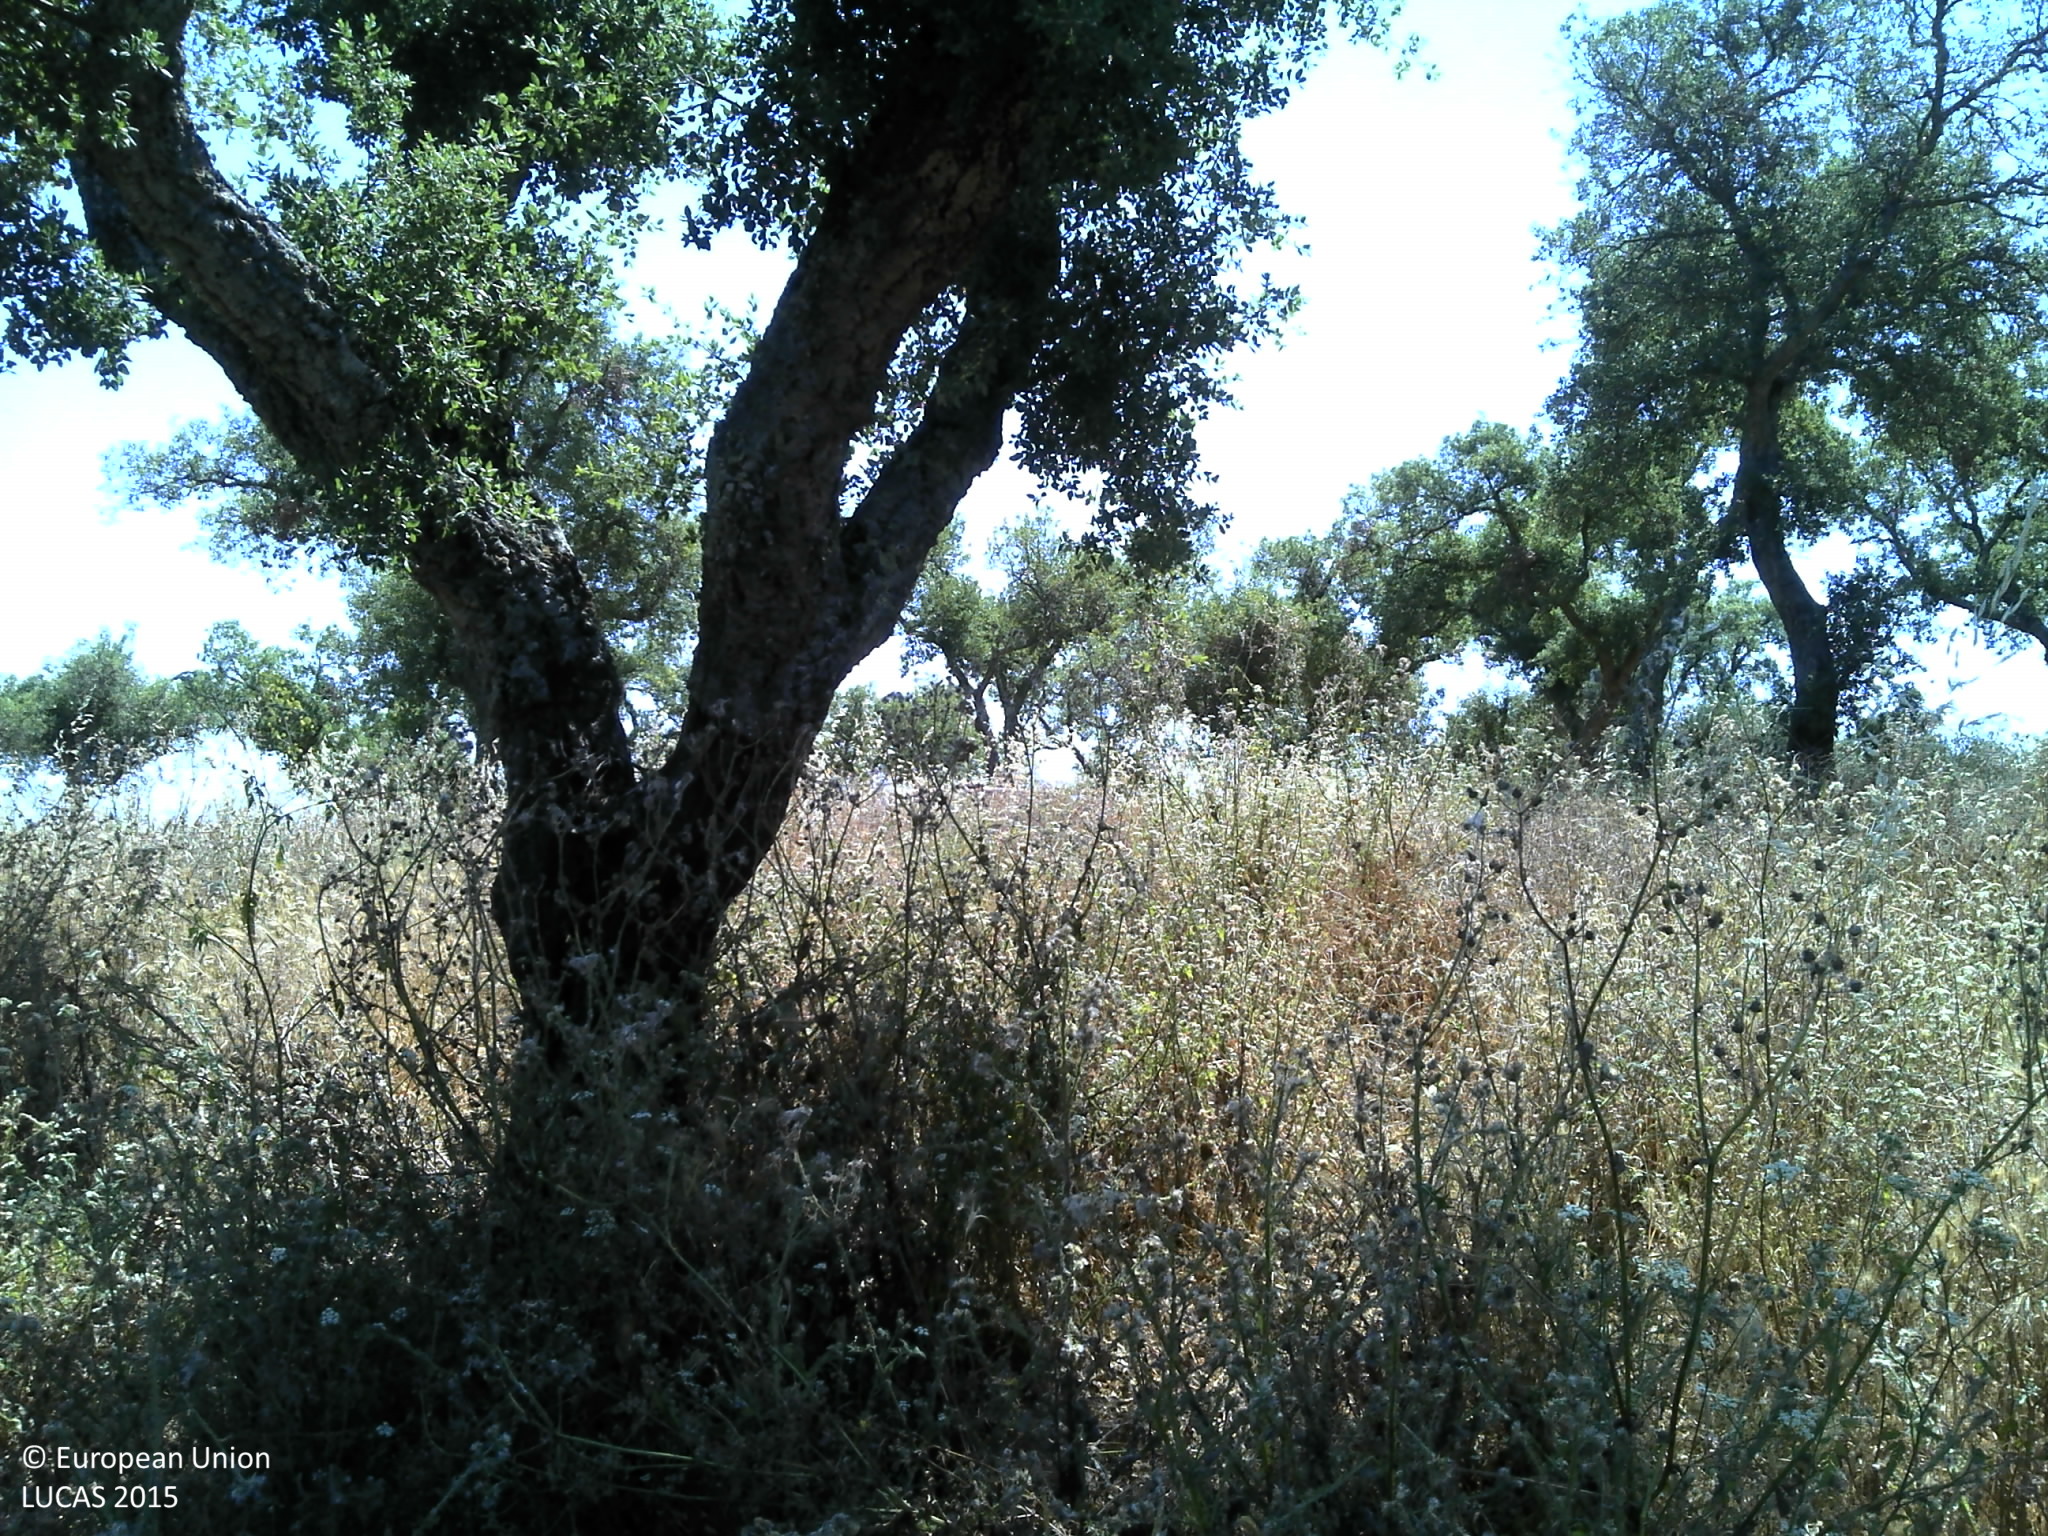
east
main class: Woodland
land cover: Broadleaved woodland
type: broadleaved evergreen forest
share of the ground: > 75 %
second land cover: Grassland without tree/shrub cover
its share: > 75 %
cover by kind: broadleaved forest trees 75 %, herbaceous plants 25 %
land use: Forestry
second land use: Agriculture (excluding fallow land and kitchen gardens)
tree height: > 5 m
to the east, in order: Broadleaved woodland; Grassland without tree/shrub cover; Broadleaved woodland; Tracks; Broadleaved woodland; Tracks; Broadleaved woodland
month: June
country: PT
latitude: 38.6210
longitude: -8.1124
